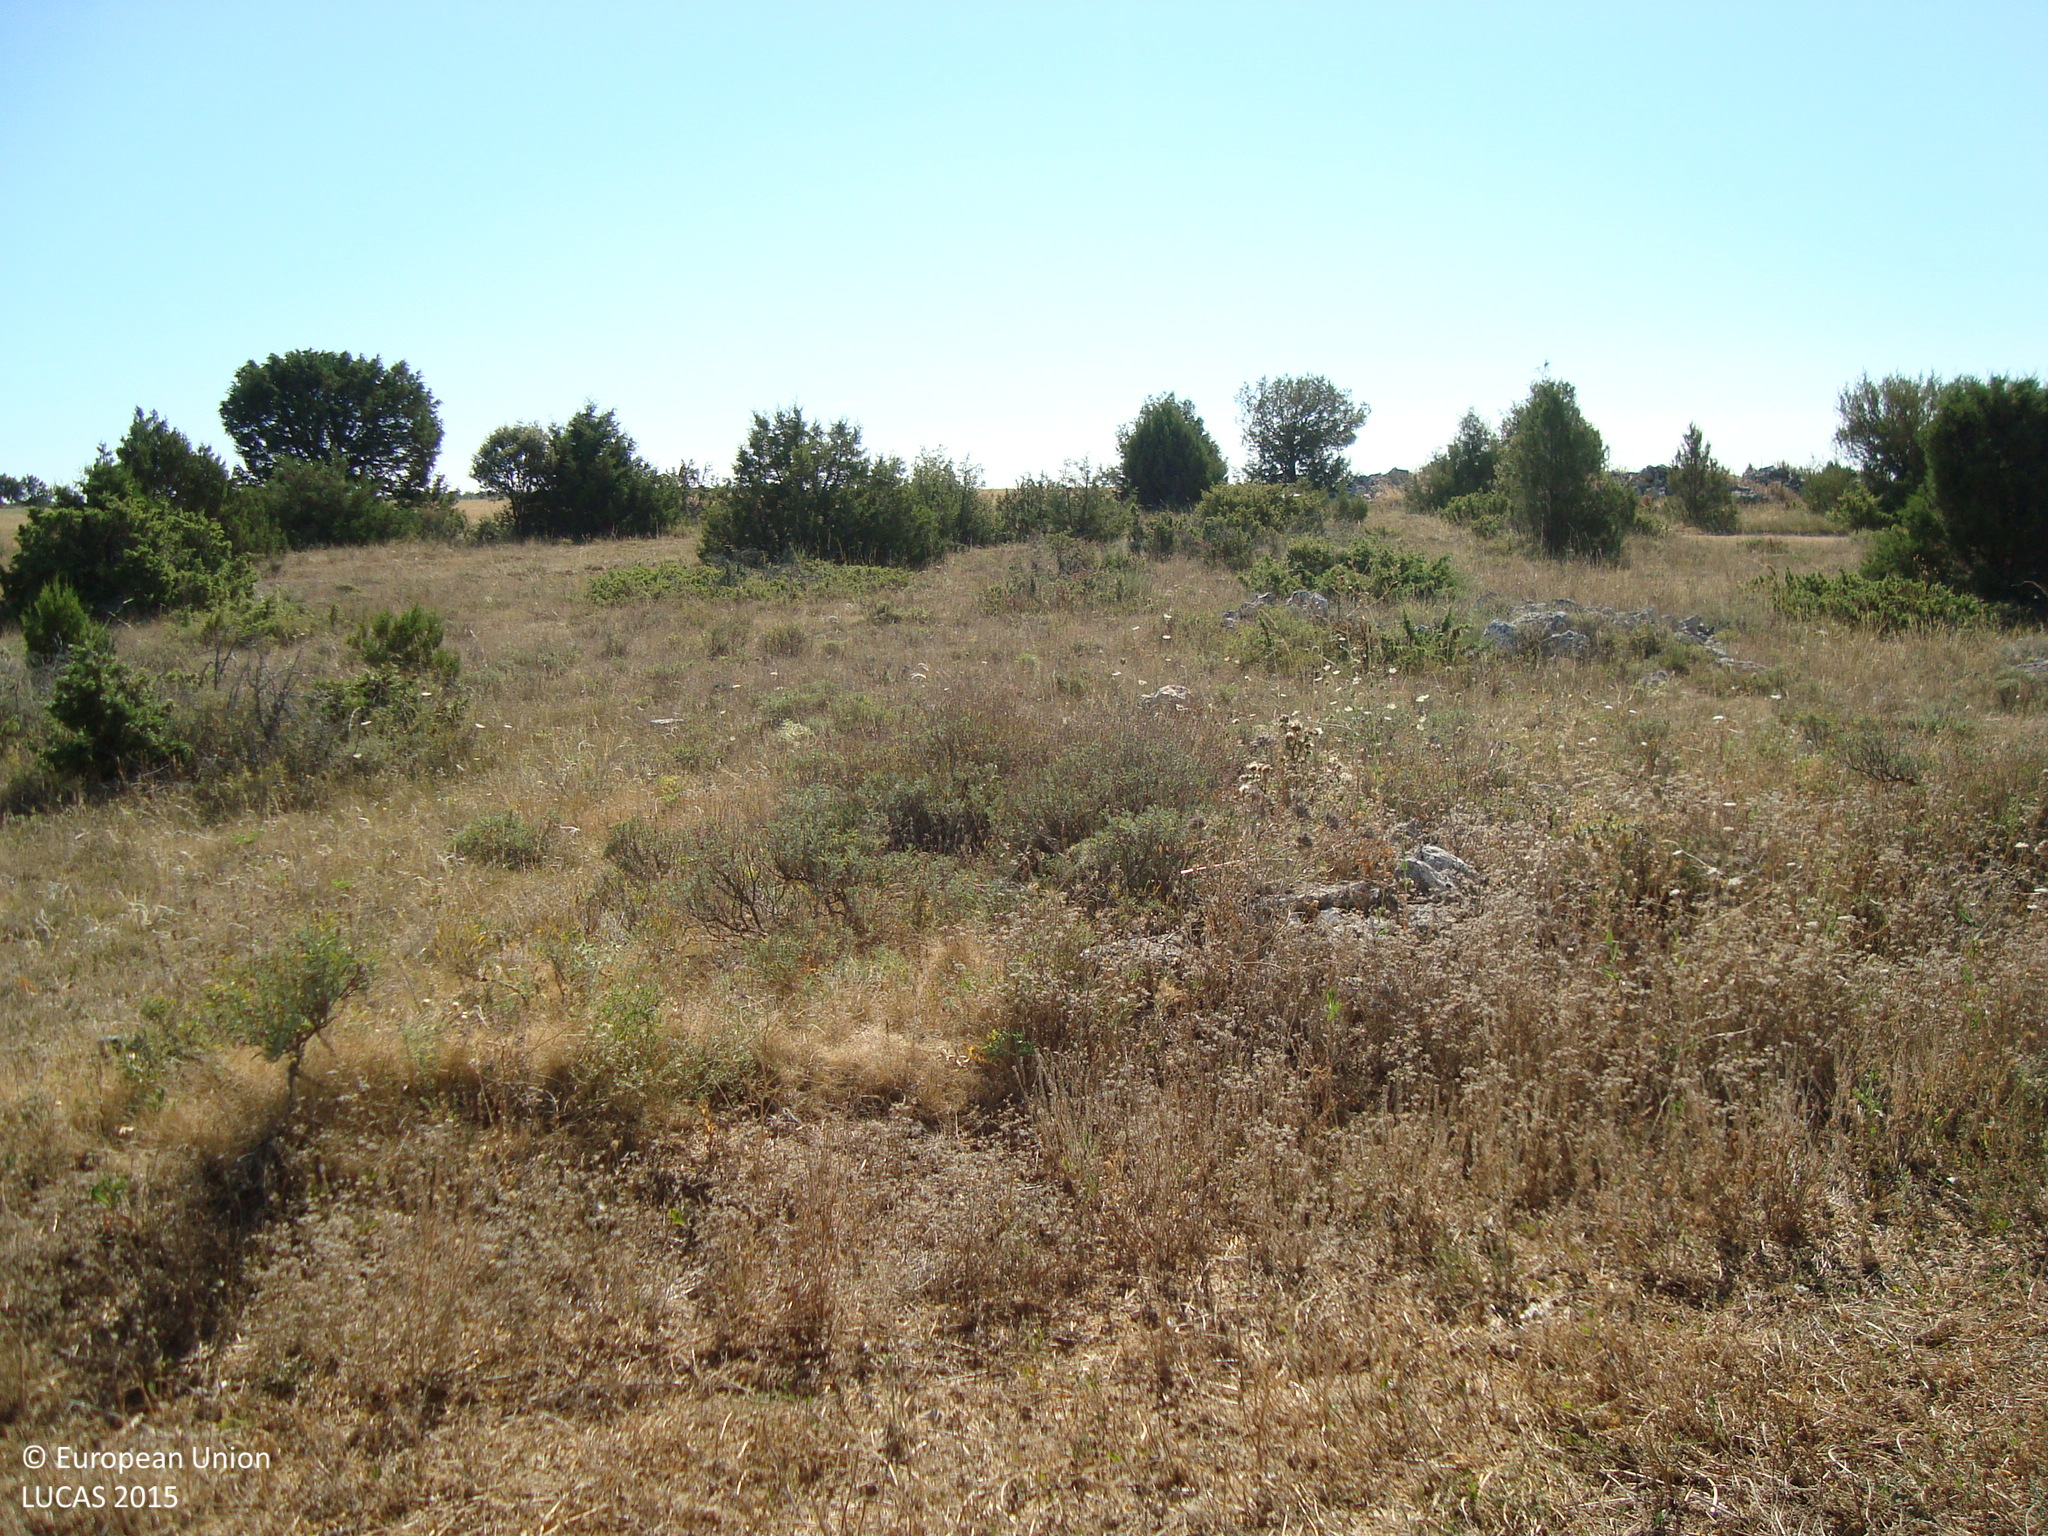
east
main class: Cropland
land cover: Dry pulses
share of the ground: > 75 %
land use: Agriculture (excluding fallow land and kitchen gardens)
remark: Harvested field
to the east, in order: Dry pulses; Grassland with sparse tree/shrub cover; Tracks; Grassland with sparse tree/shrub cover; Tracks; Grassland with sparse tree/shrub cover; Common wheat
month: July
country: ES
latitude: 41.9028
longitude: -4.0808
